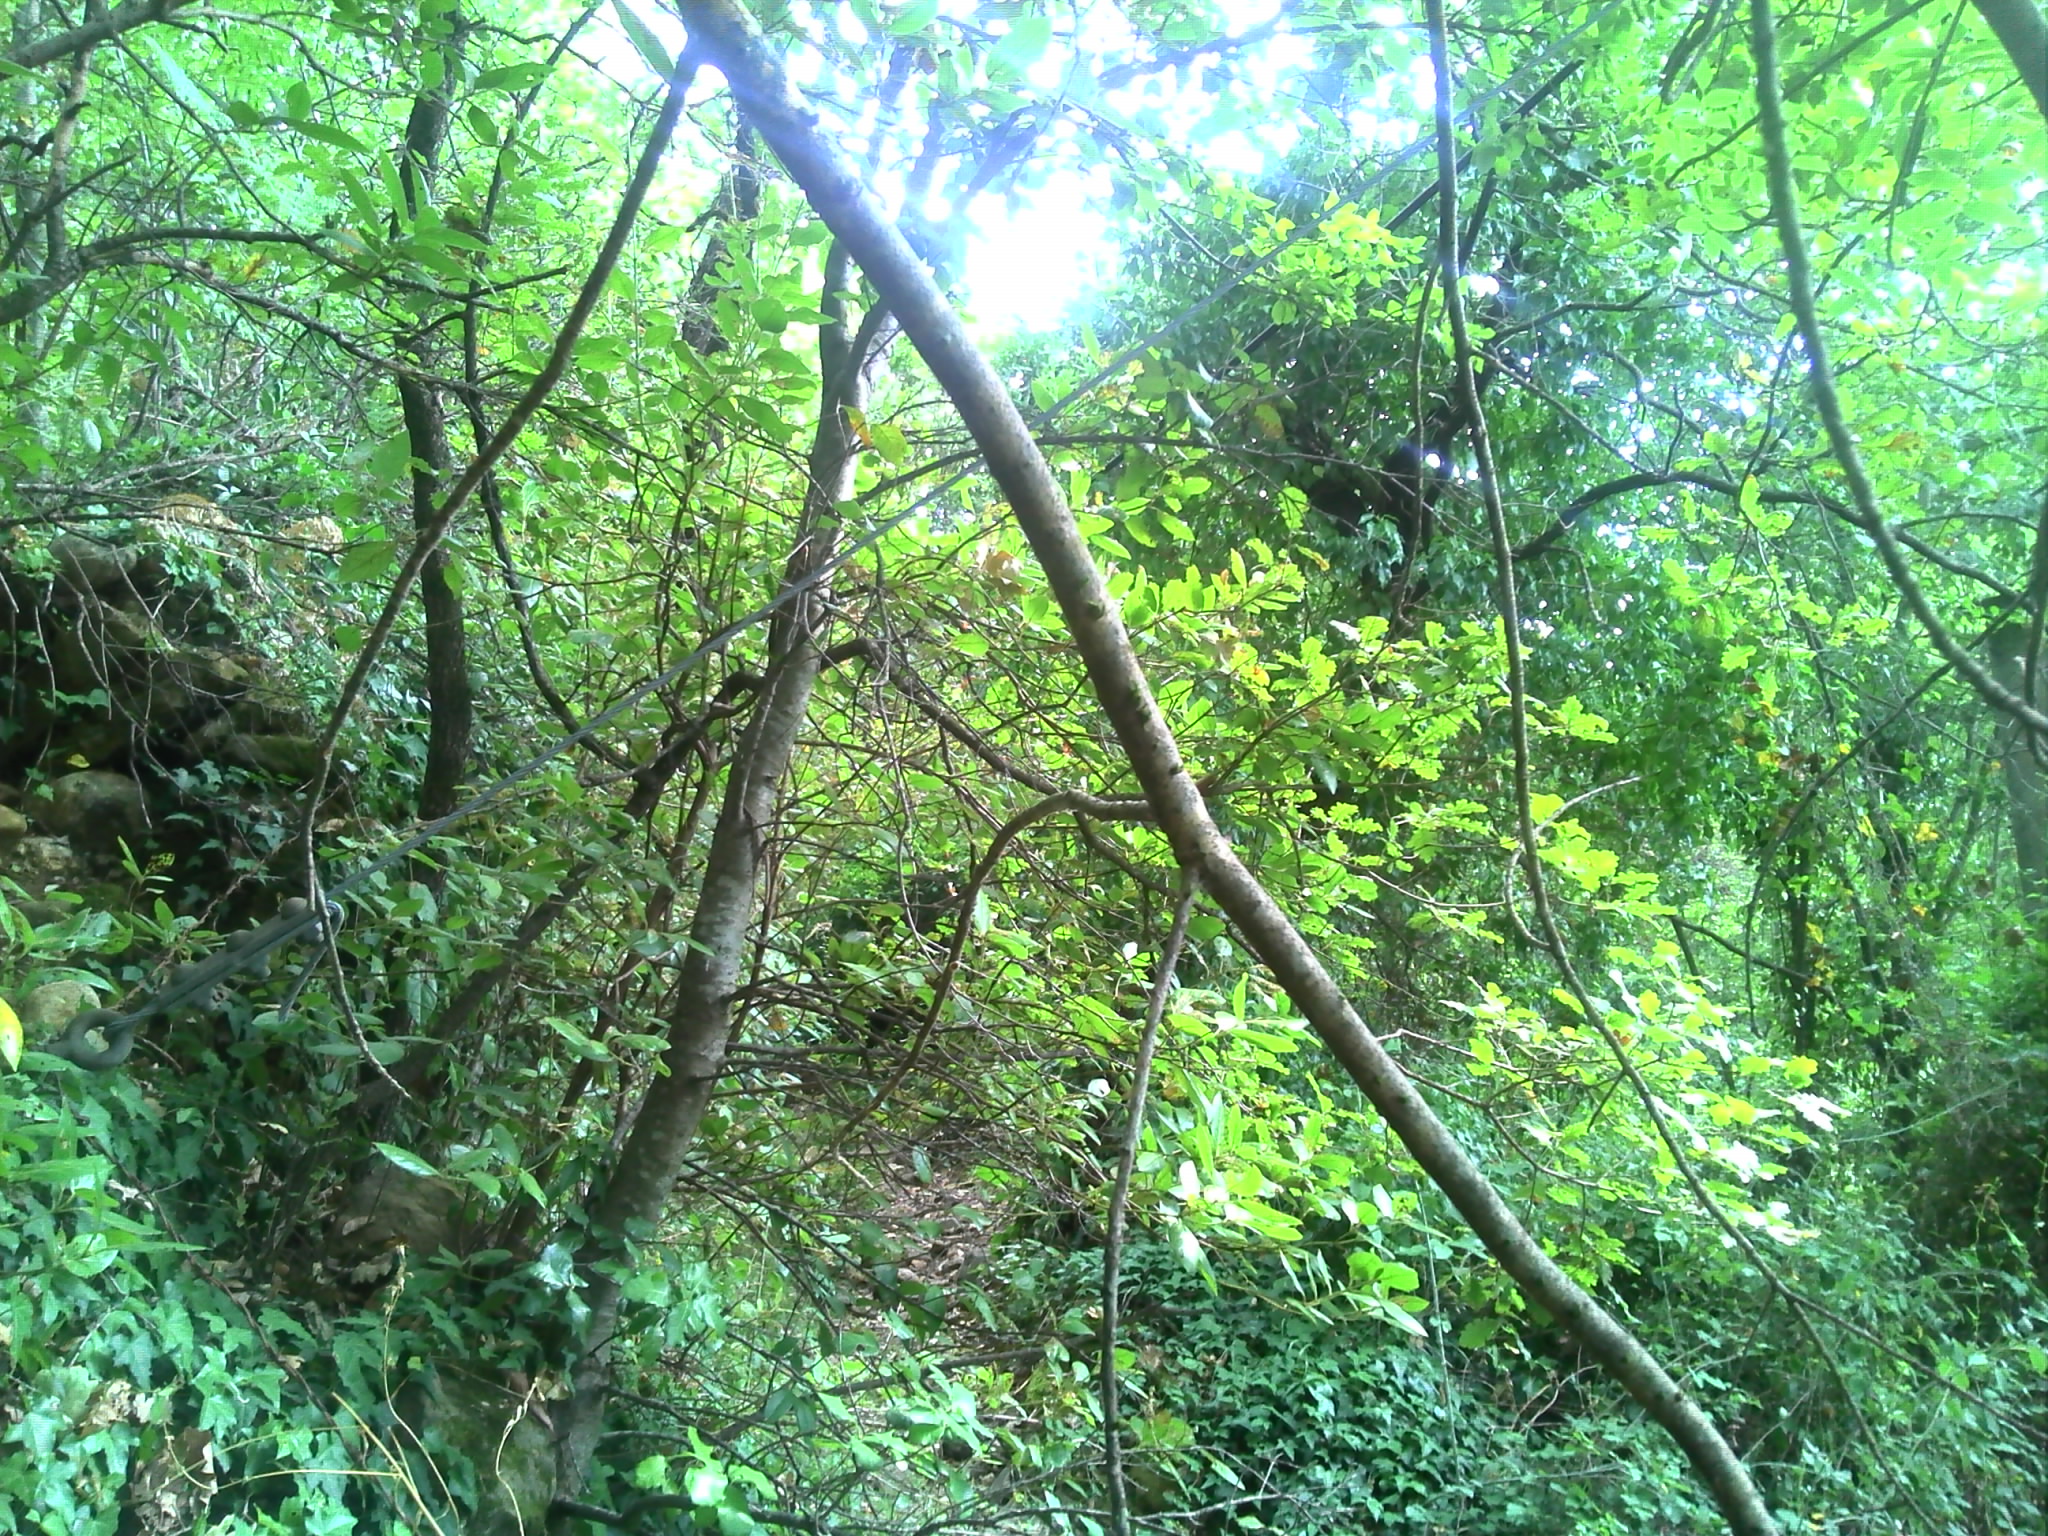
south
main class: Woodland
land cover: Broadleaved woodland
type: mesophytic deciduous forest
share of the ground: > 75 %
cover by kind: broadleaved forest trees 80 %, herbaceous plants 10 %, consolidated bare surface 10 %
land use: Forestry
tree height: > 5 m
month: July
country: FR
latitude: 44.1016
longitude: 3.9487
